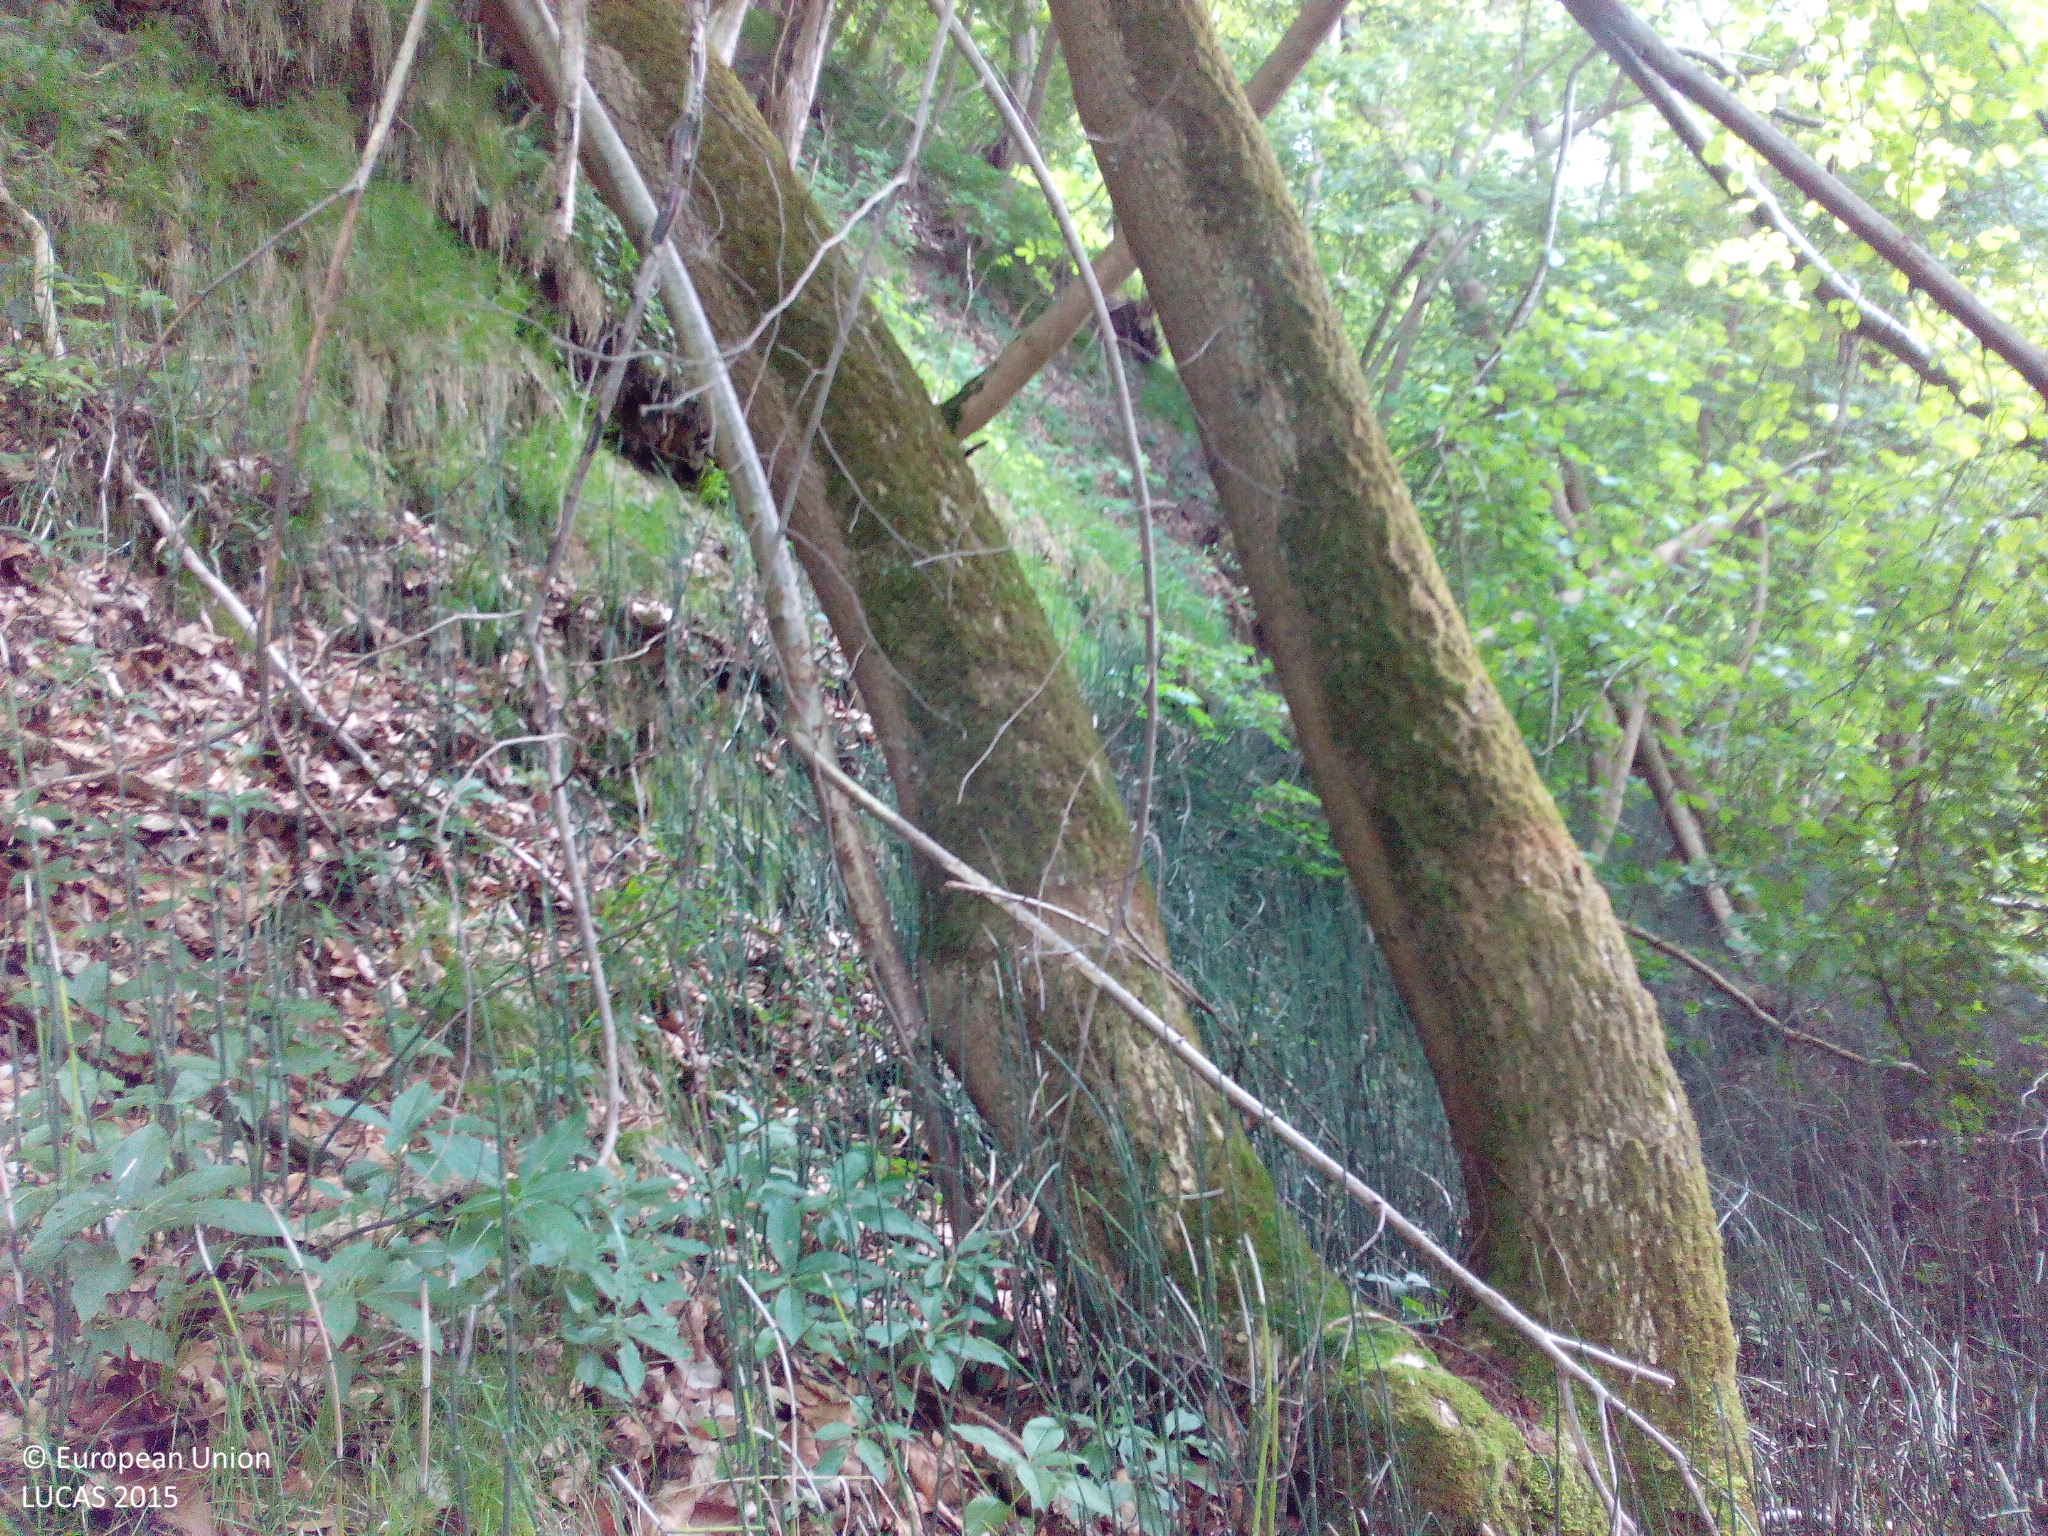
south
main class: Woodland
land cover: Broadleaved woodland
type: mesophytic deciduous forest
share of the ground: > 75 %
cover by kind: broadleaved forest trees 80 %, herbaceous plants 20 %
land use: Semi-natural and natural areas not in use
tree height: > 5 m
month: May
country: DE
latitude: 48.6126
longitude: 12.3457
